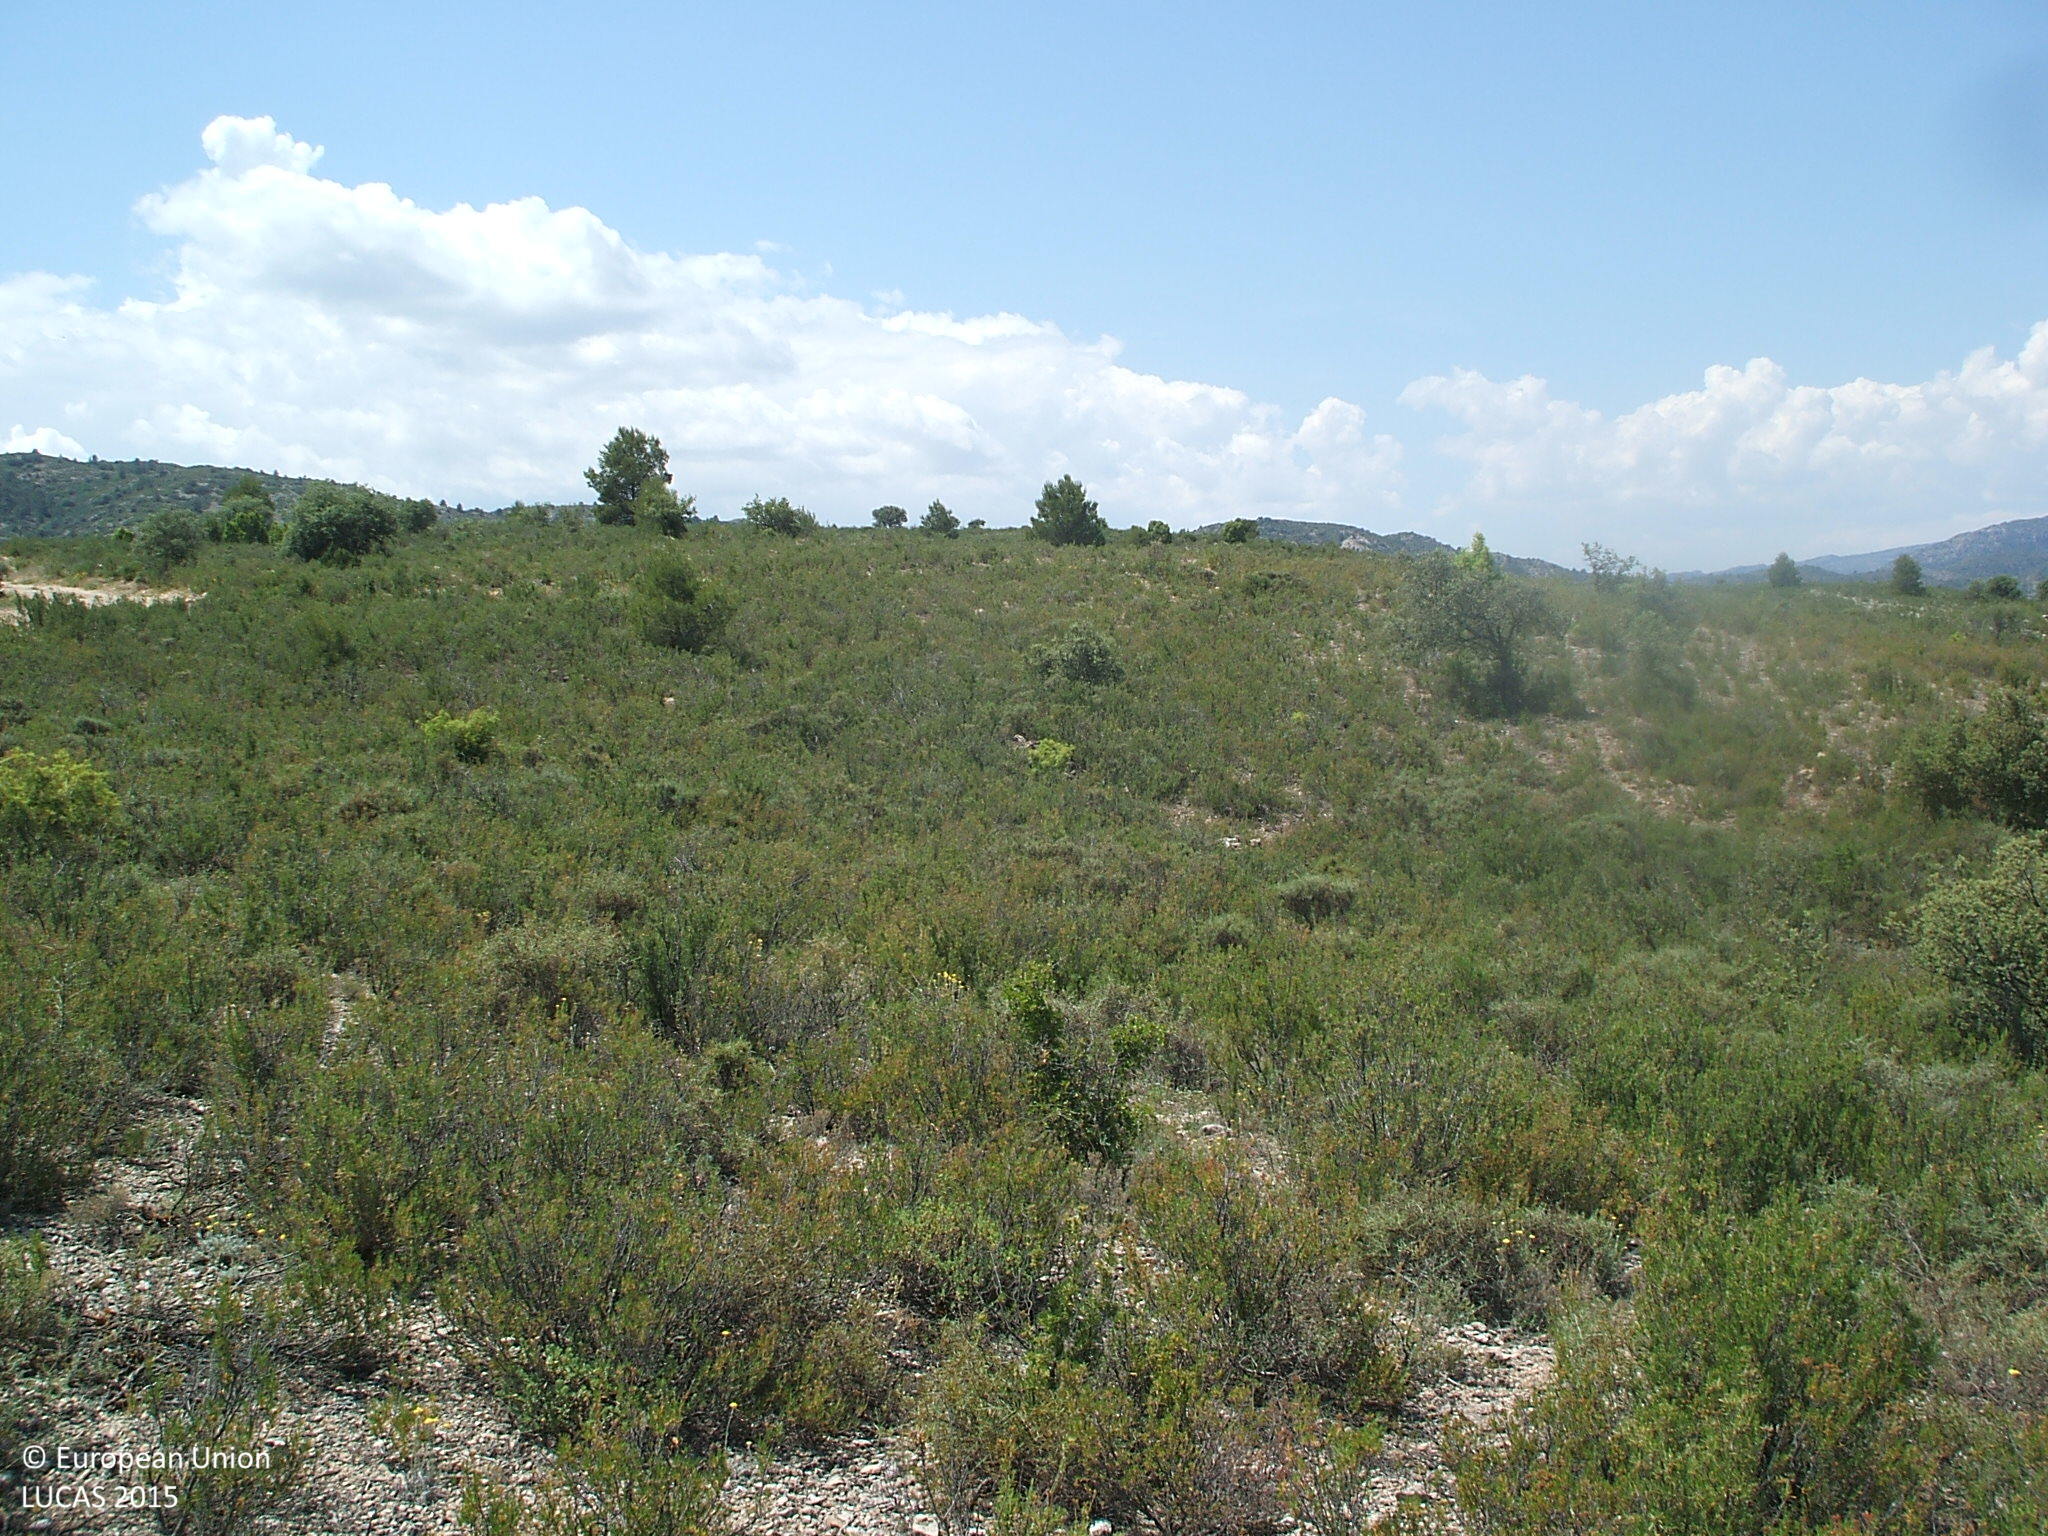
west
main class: Shrubland
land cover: Shrubland with sparse tree cover
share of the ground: > 75 %
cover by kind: shrubs 80 %, consolidated bare surface 15 %, coniferous forest trees 5 %
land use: Semi-natural and natural areas not in use
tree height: > 5 m
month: June
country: ES
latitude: 40.8254
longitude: -0.2189
